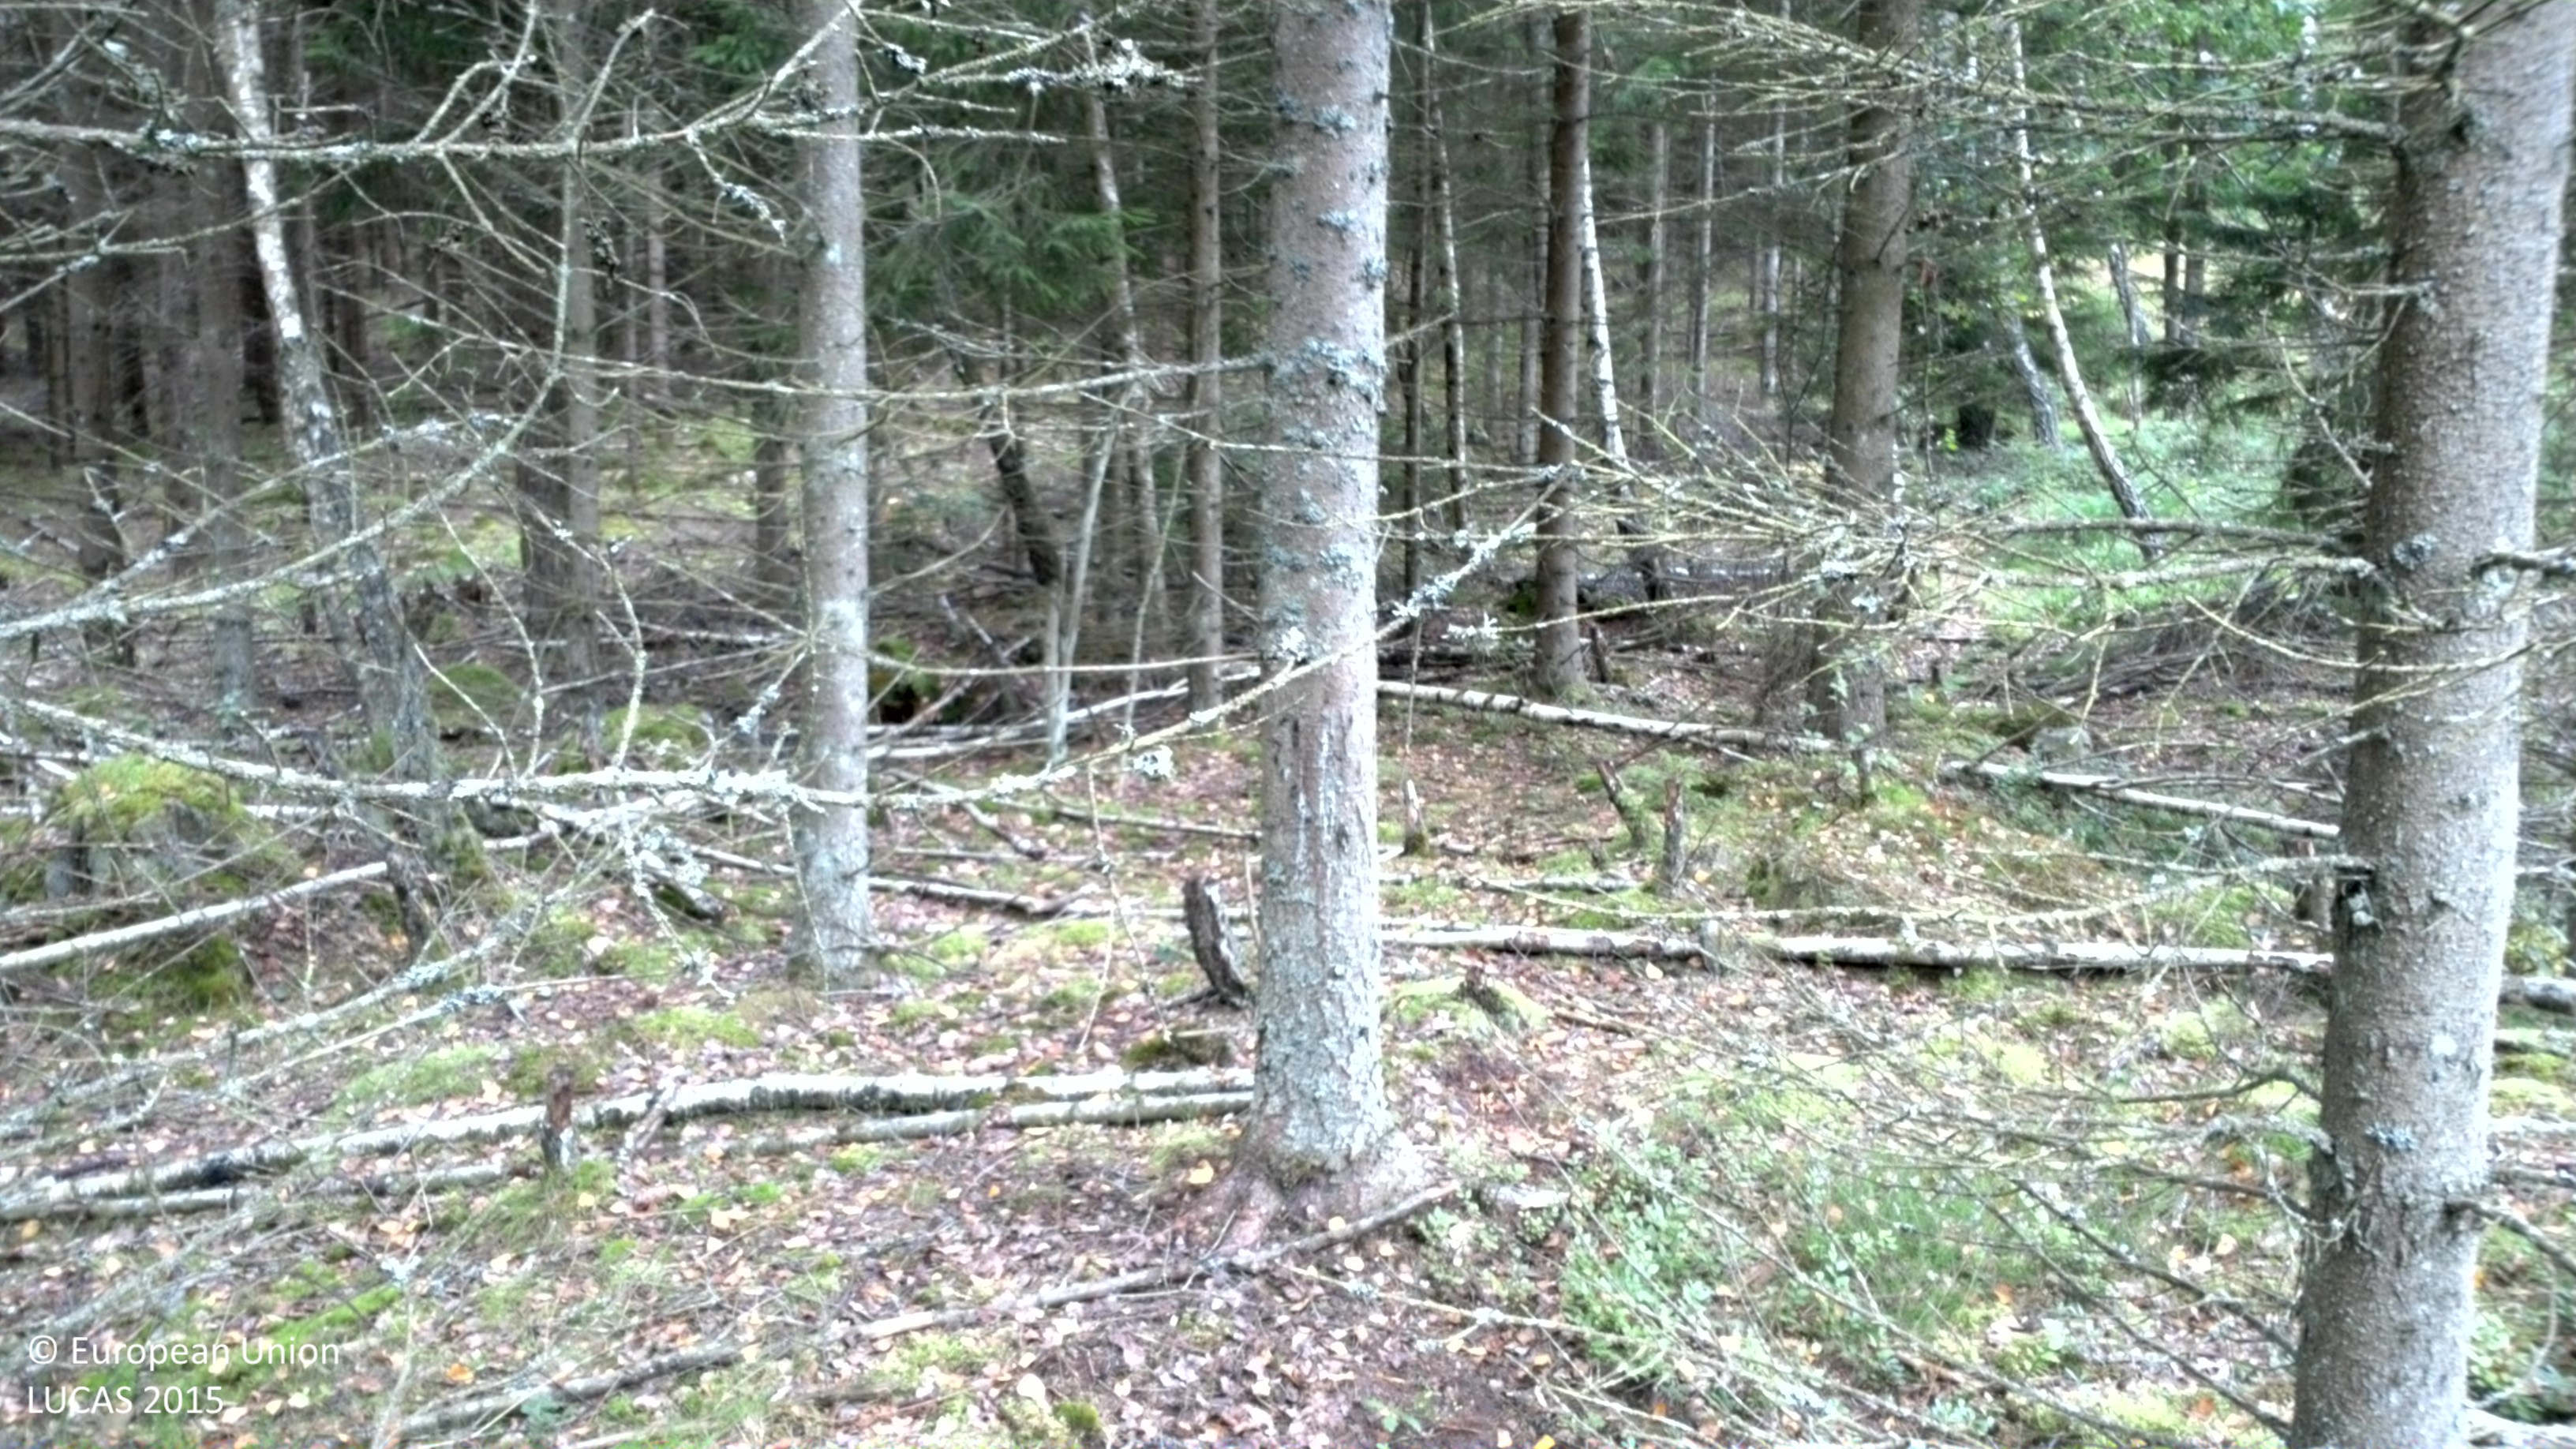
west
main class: Woodland
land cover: Spruce dominated mixed woodland
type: boreal forest
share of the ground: 50 - 75 %
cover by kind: coniferous forest trees 50 %, broadleaved forest trees 20 %, shrubs 15 %, lichens and mosses 15 %
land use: Forestry
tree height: > 5 m
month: August
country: SE
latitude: 56.3334
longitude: 14.2514
